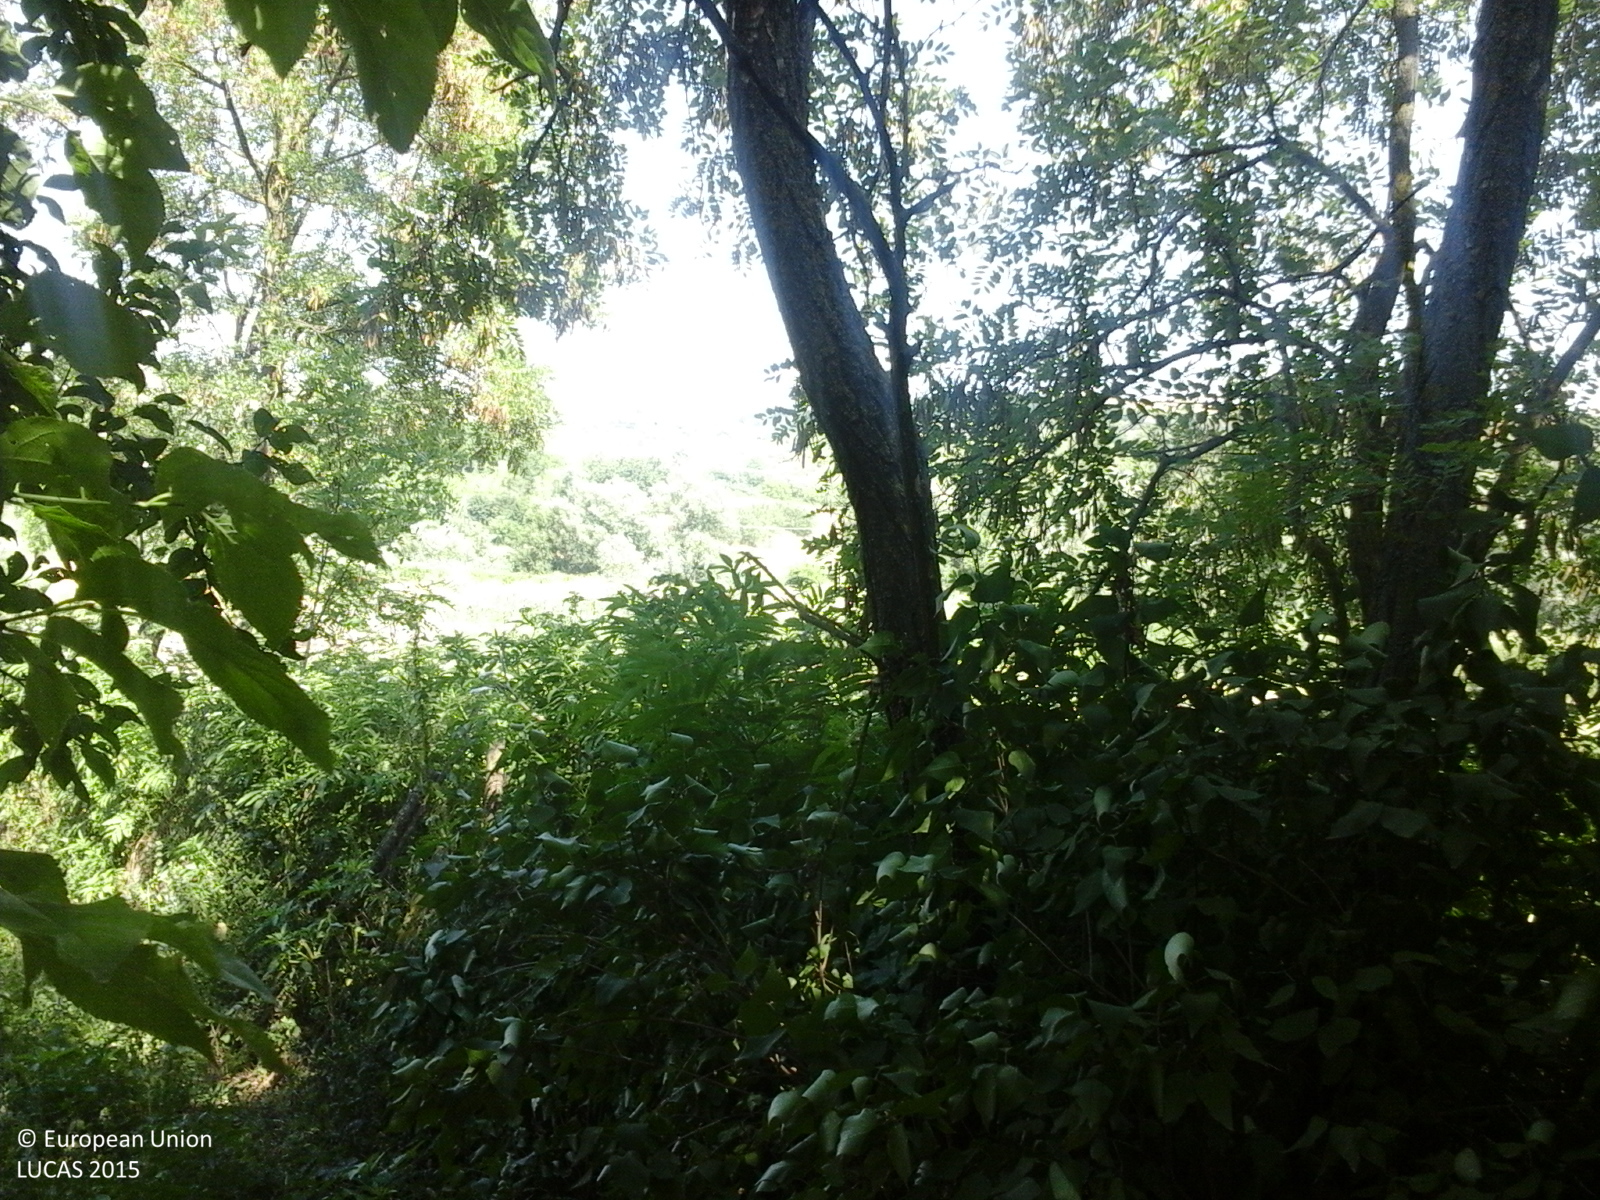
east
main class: Cropland
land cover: Other fruit trees and berries
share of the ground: 50 - 75 %
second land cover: Grassland without tree/shrub cover
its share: 10 - 25 %
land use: Agriculture (excluding fallow land and kitchen gardens)
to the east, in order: Other fruit trees and berries; Grassland without tree/shrub cover; Tracks; Abandoned hedges; Fences; Grassland without tree/shrub cover; Fences; Grass margins; Tracks; Grass margins; Ditches and canals; Grass margins; Maize; Grass margins; Tracks; Grass margins; Maize; Abandoned hedges; Rivers and streams; Abandoned hedges; Grassland without tree/shrub cover; Tracks; Grassland without tree/shrub cover; Paved roads, cycling and walking lanes
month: July
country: RO
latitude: 46.3284
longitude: 27.2881
